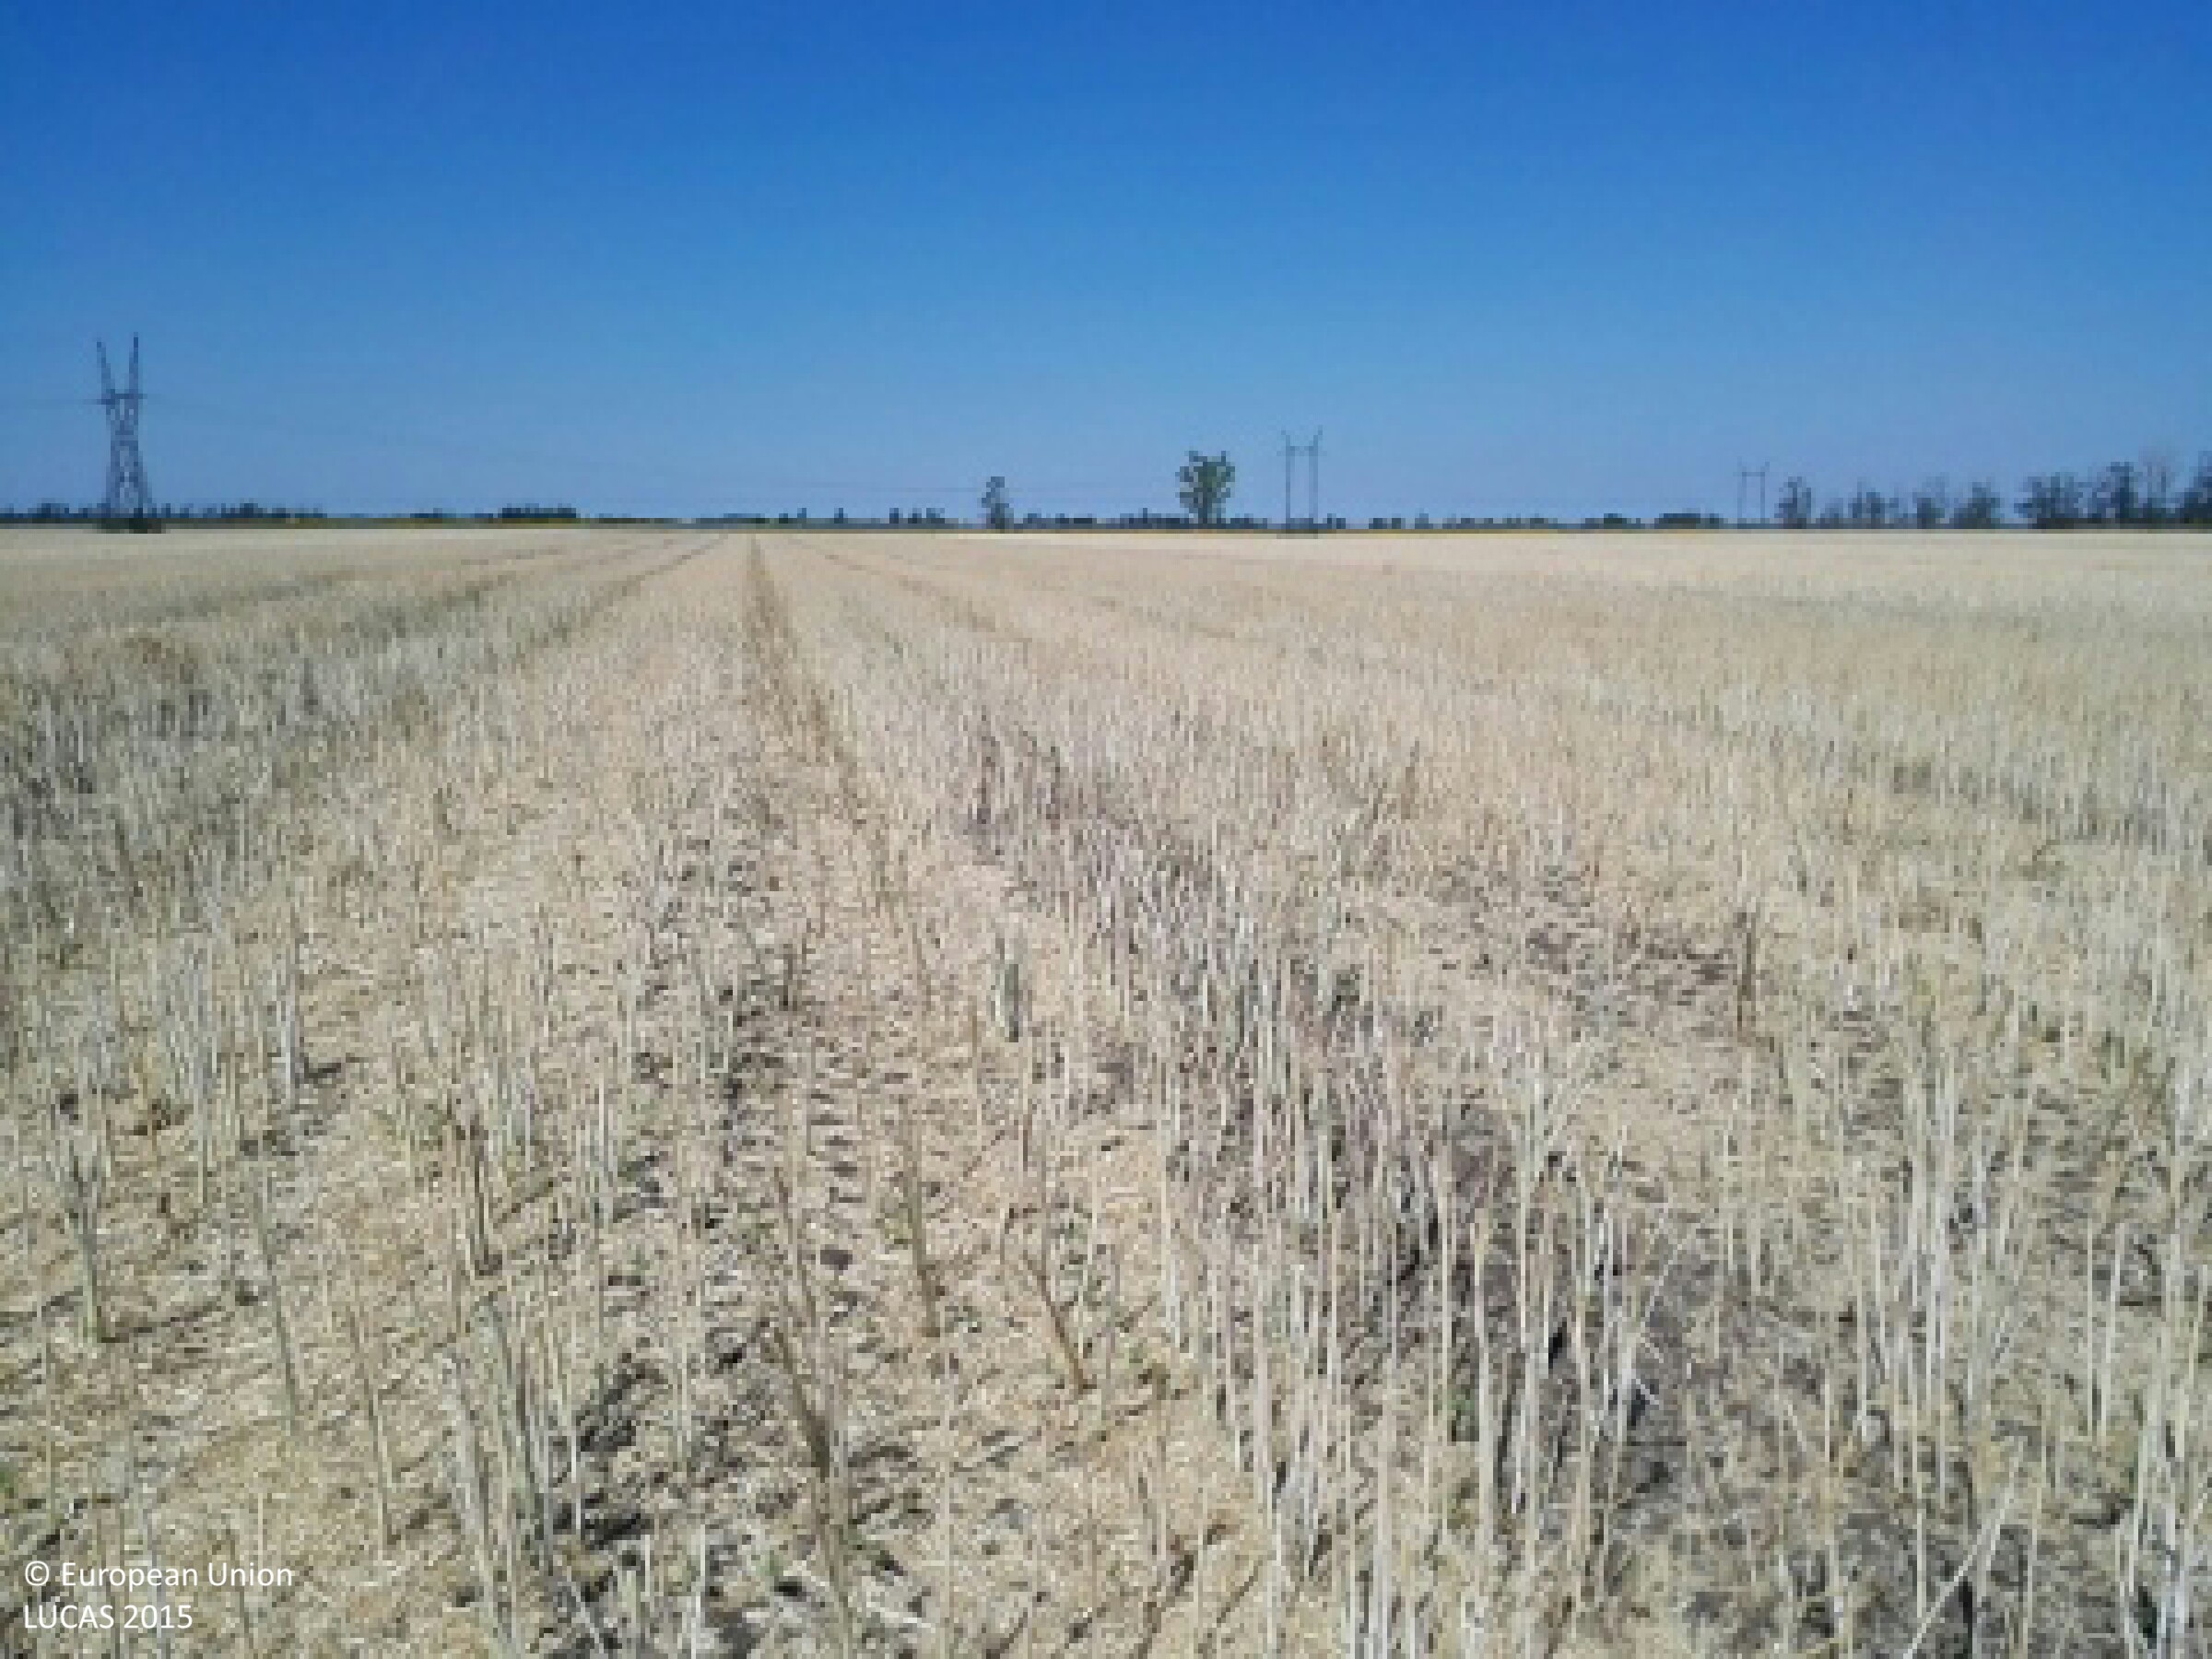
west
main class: Cropland
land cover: Rape and turnip rape
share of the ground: > 75 %
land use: Agriculture (excluding fallow land and kitchen gardens)
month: July
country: HU
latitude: 47.7522
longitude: 21.4482
